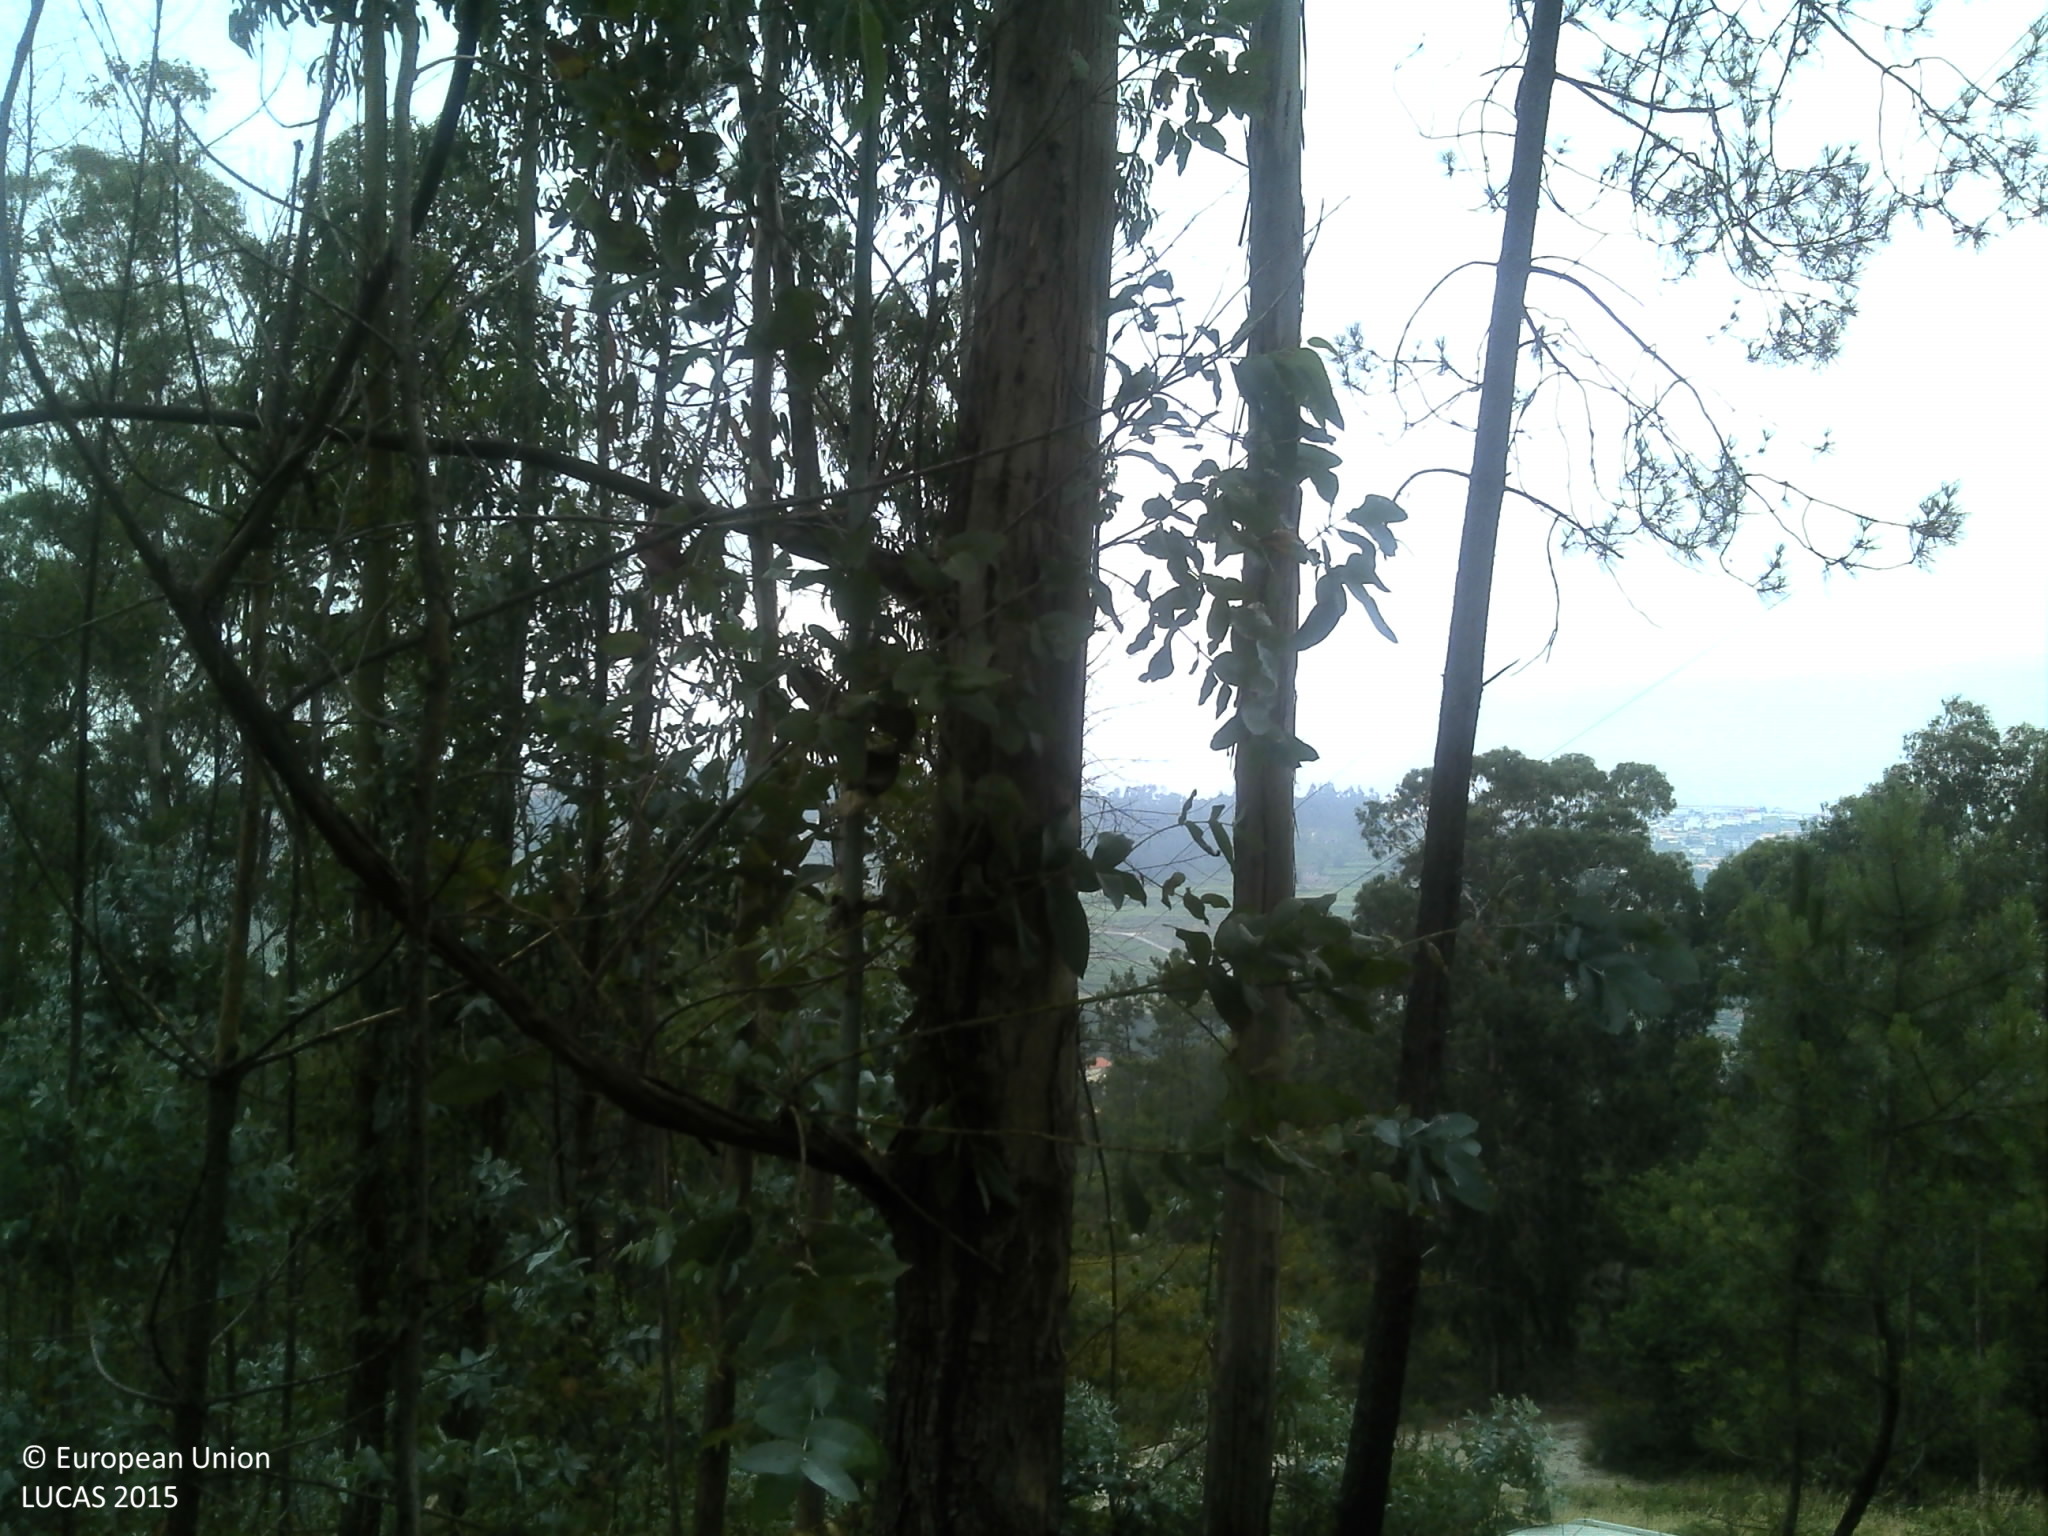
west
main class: Woodland
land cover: Broadleaved woodland
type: exotic forest
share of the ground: 50 - 75 %
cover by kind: broadleaved forest trees 70 %, shrubs 25 %, unconsolidated bare surface 5 %
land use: Forestry
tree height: > 5 m
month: June
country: PT
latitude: 41.2912
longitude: -8.1612
